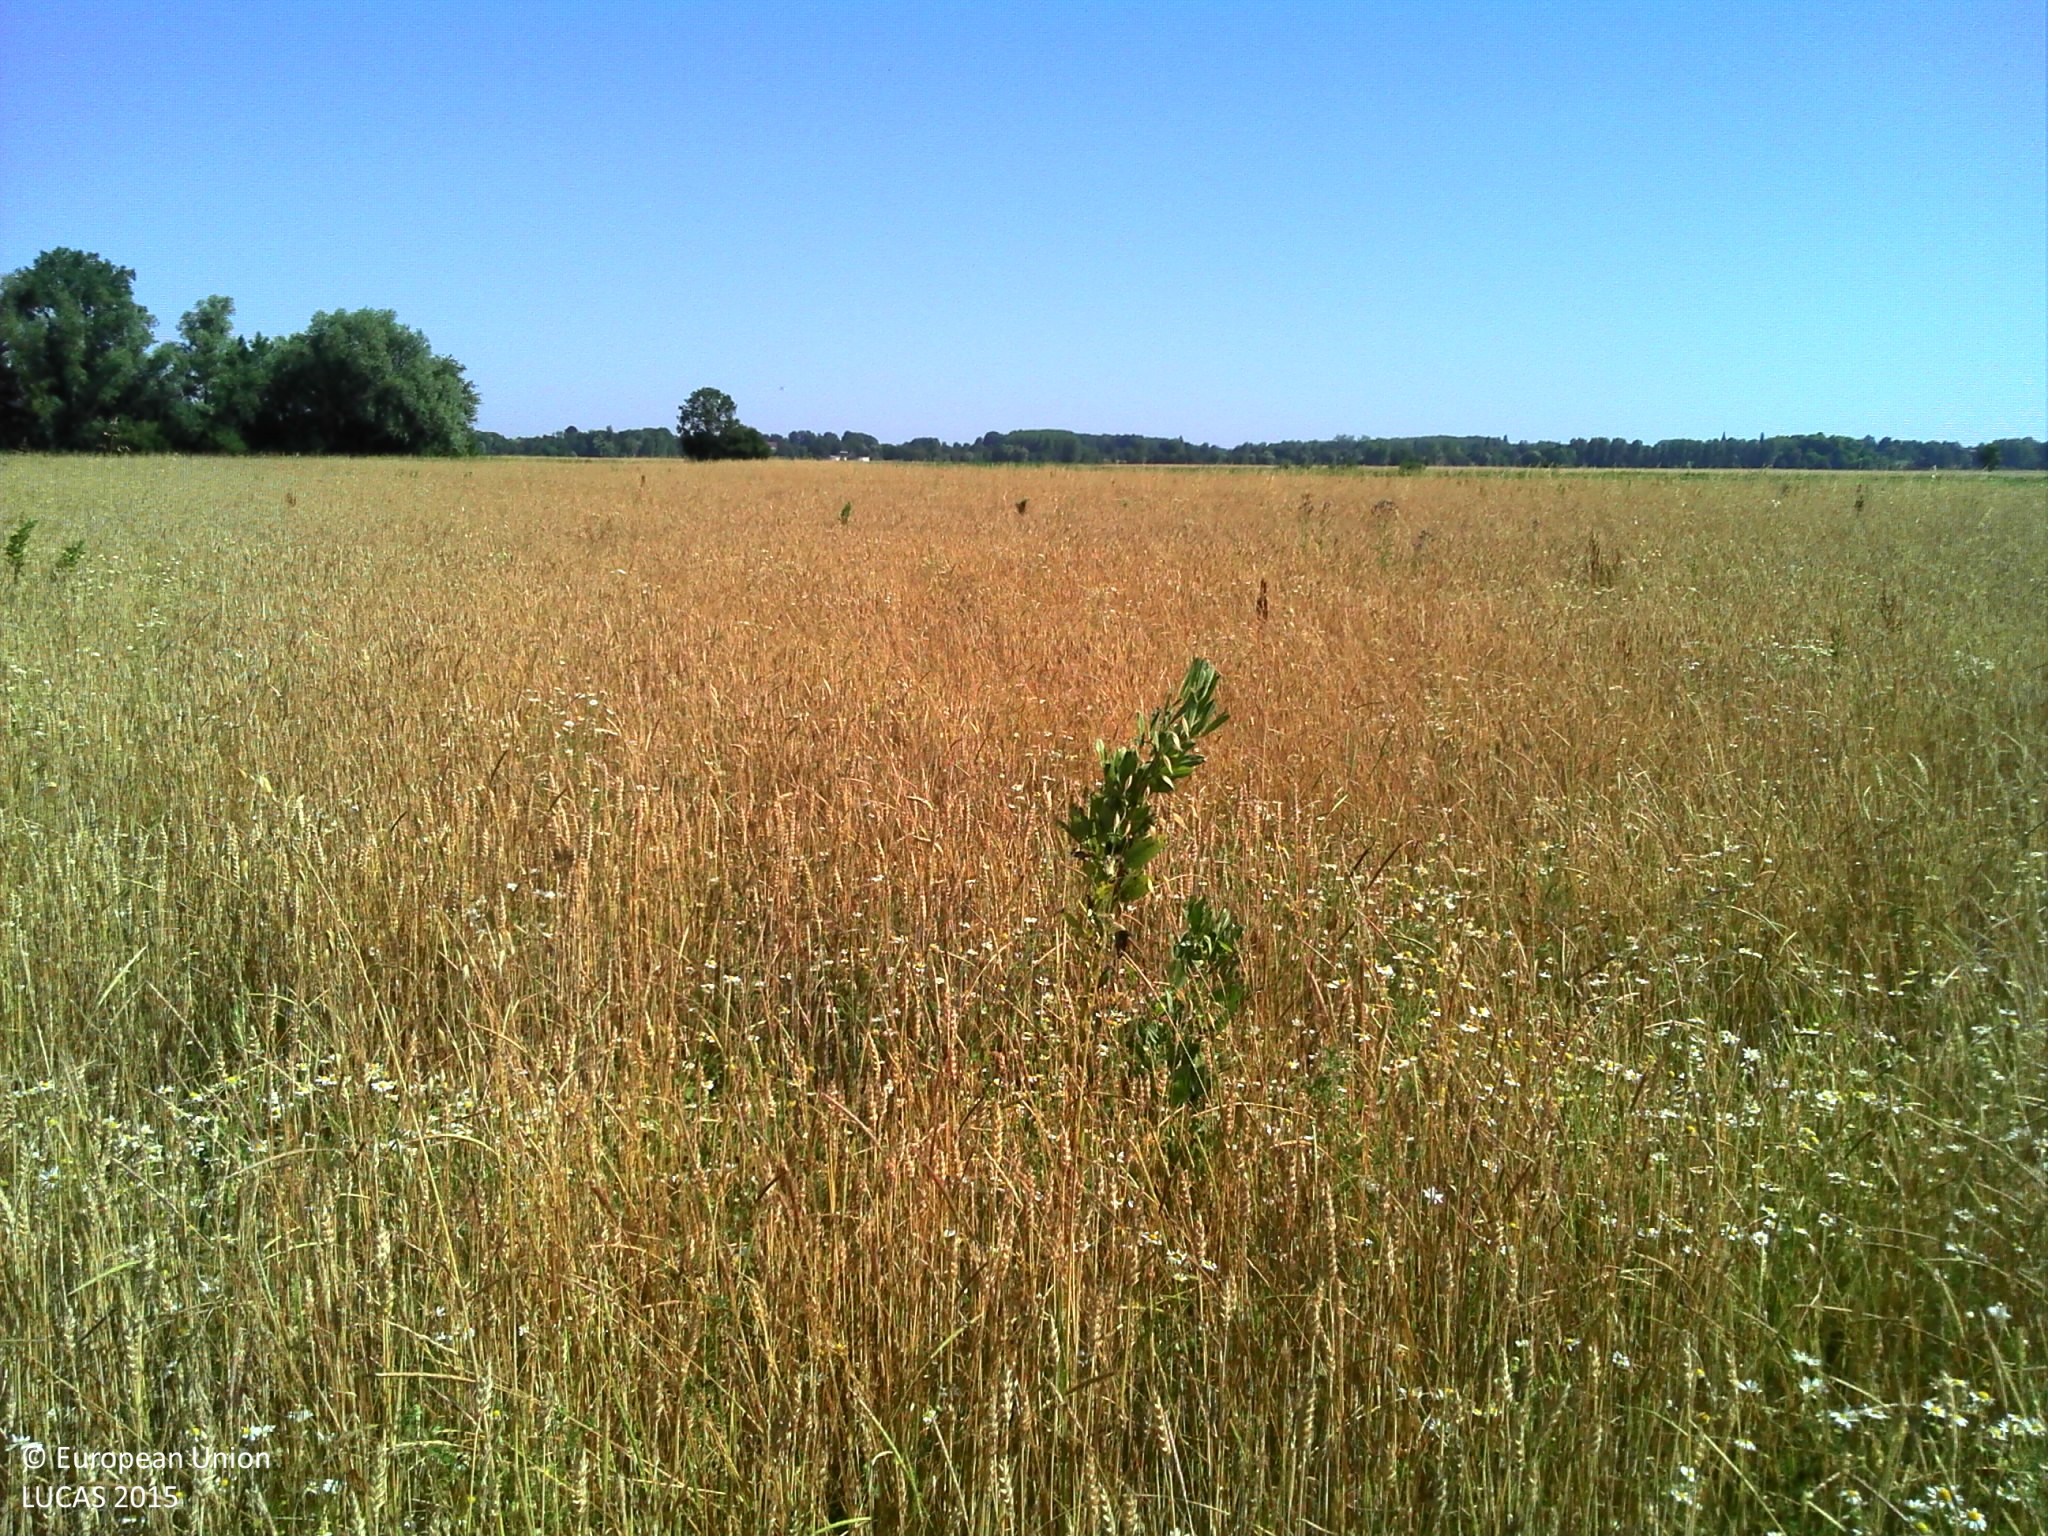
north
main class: Grassland
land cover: Grassland without tree/shrub cover
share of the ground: > 75 %
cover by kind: herbaceous plants 100 %
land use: Agriculture (excluding fallow land and kitchen gardens)
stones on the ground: < 10 %
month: June
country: FR
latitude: 46.7217
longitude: 5.4098
